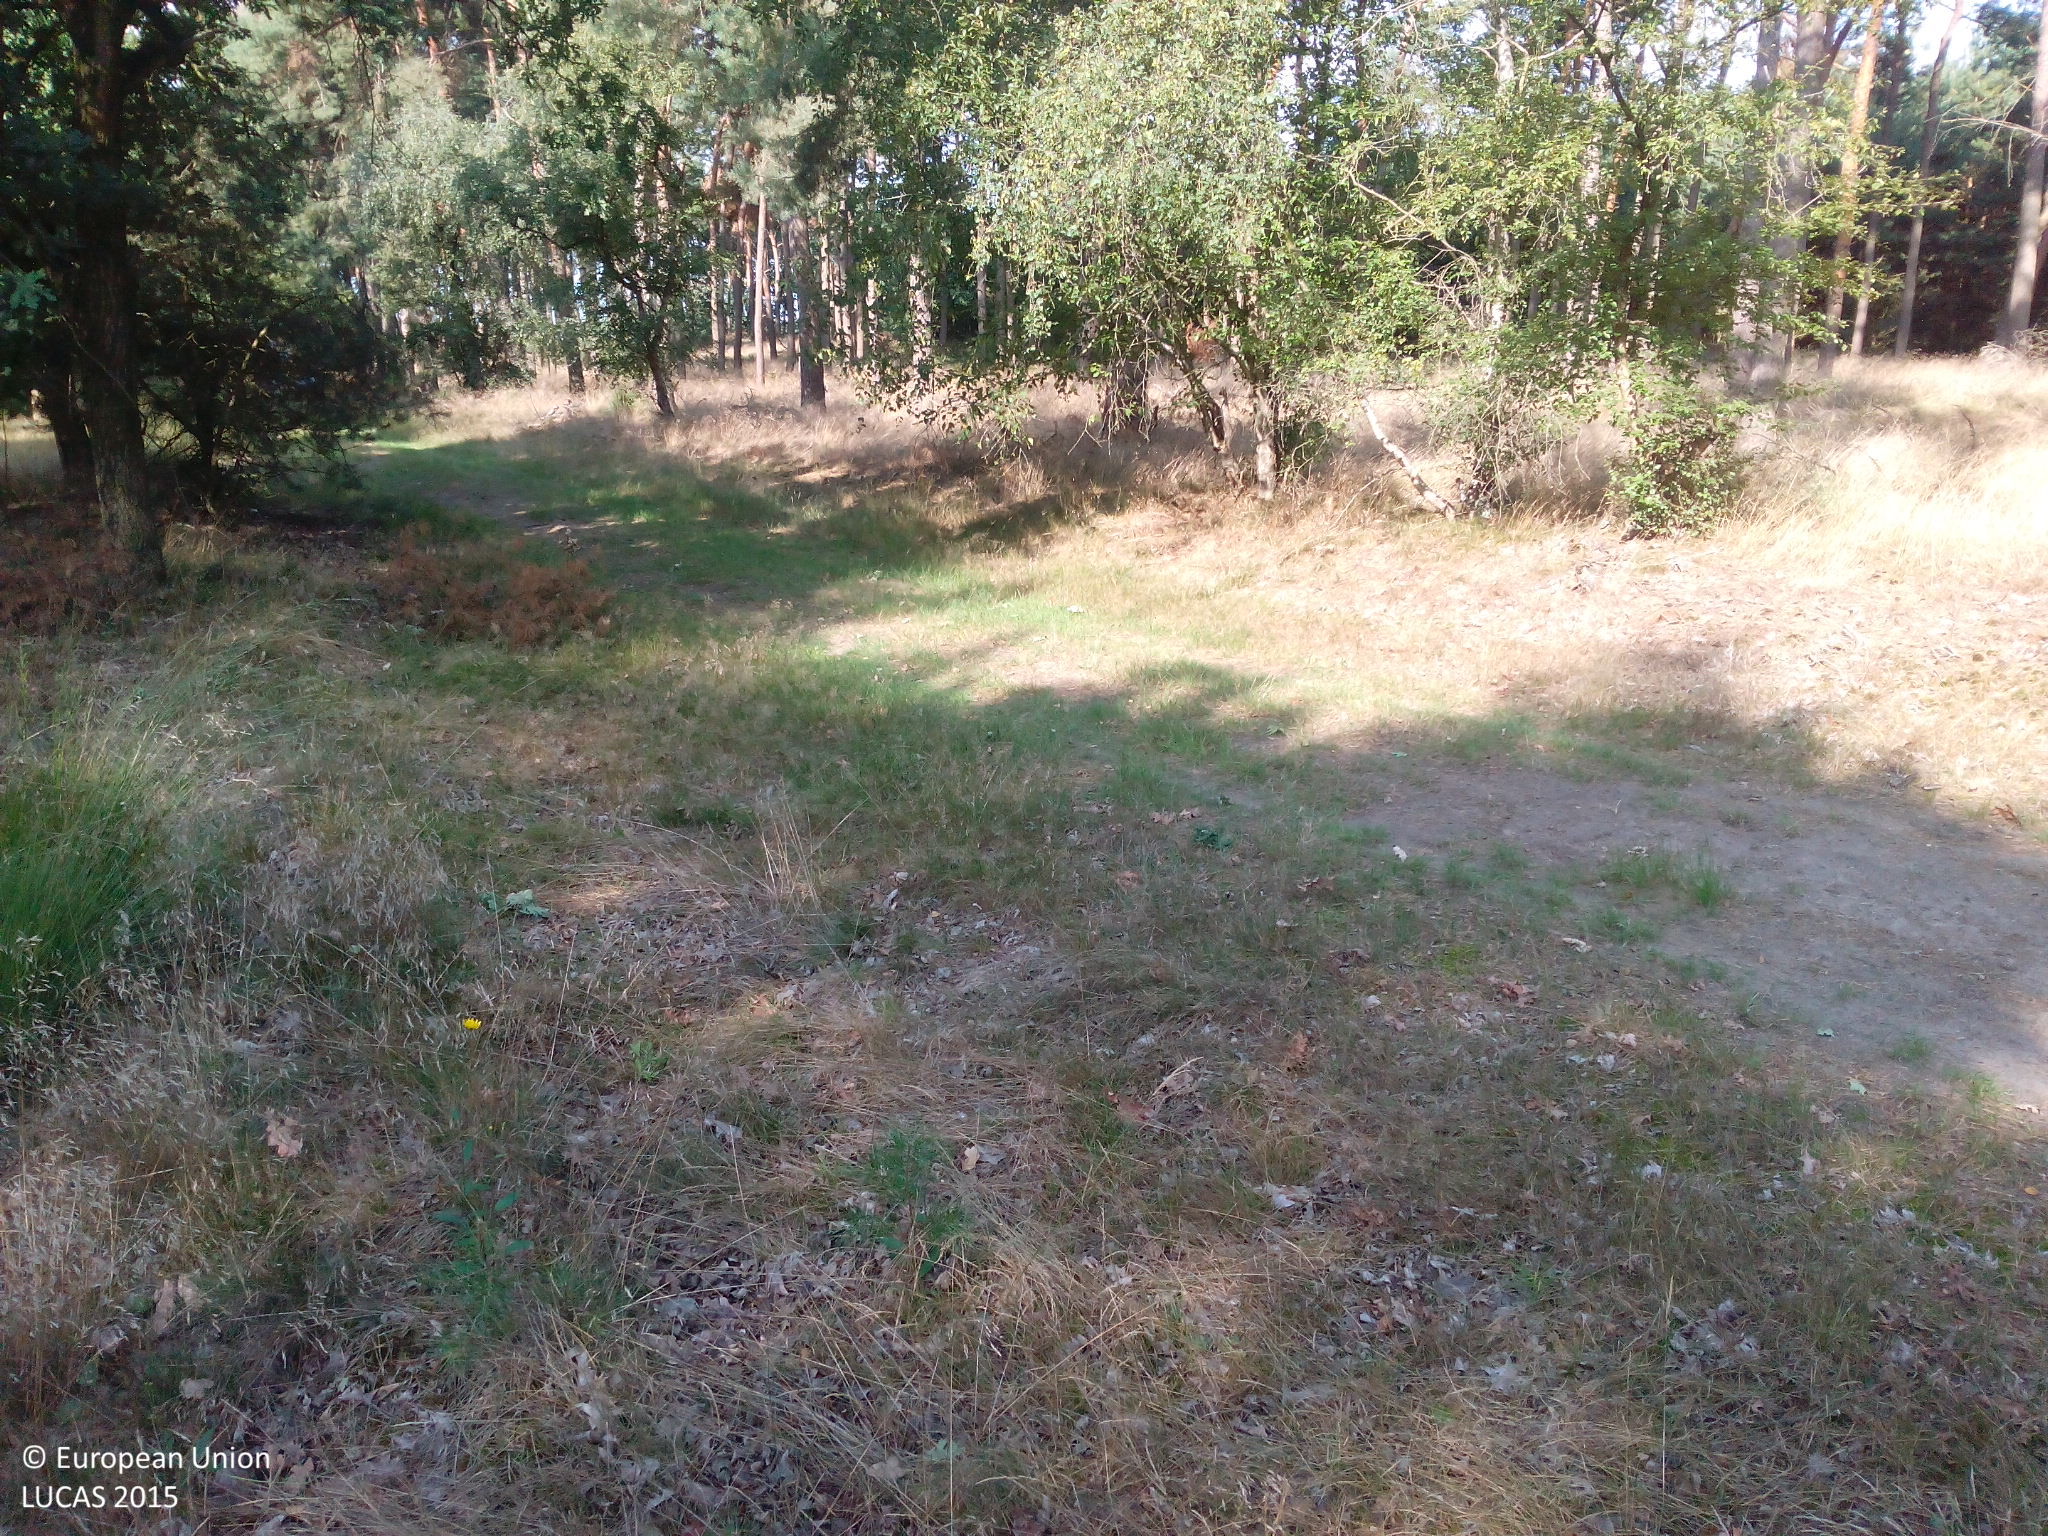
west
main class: Grassland
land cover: Grassland without tree/shrub cover
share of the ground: > 75 %
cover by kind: herbaceous plants 100 %
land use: Sport
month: August
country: NL
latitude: 51.3415
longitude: 5.5911
